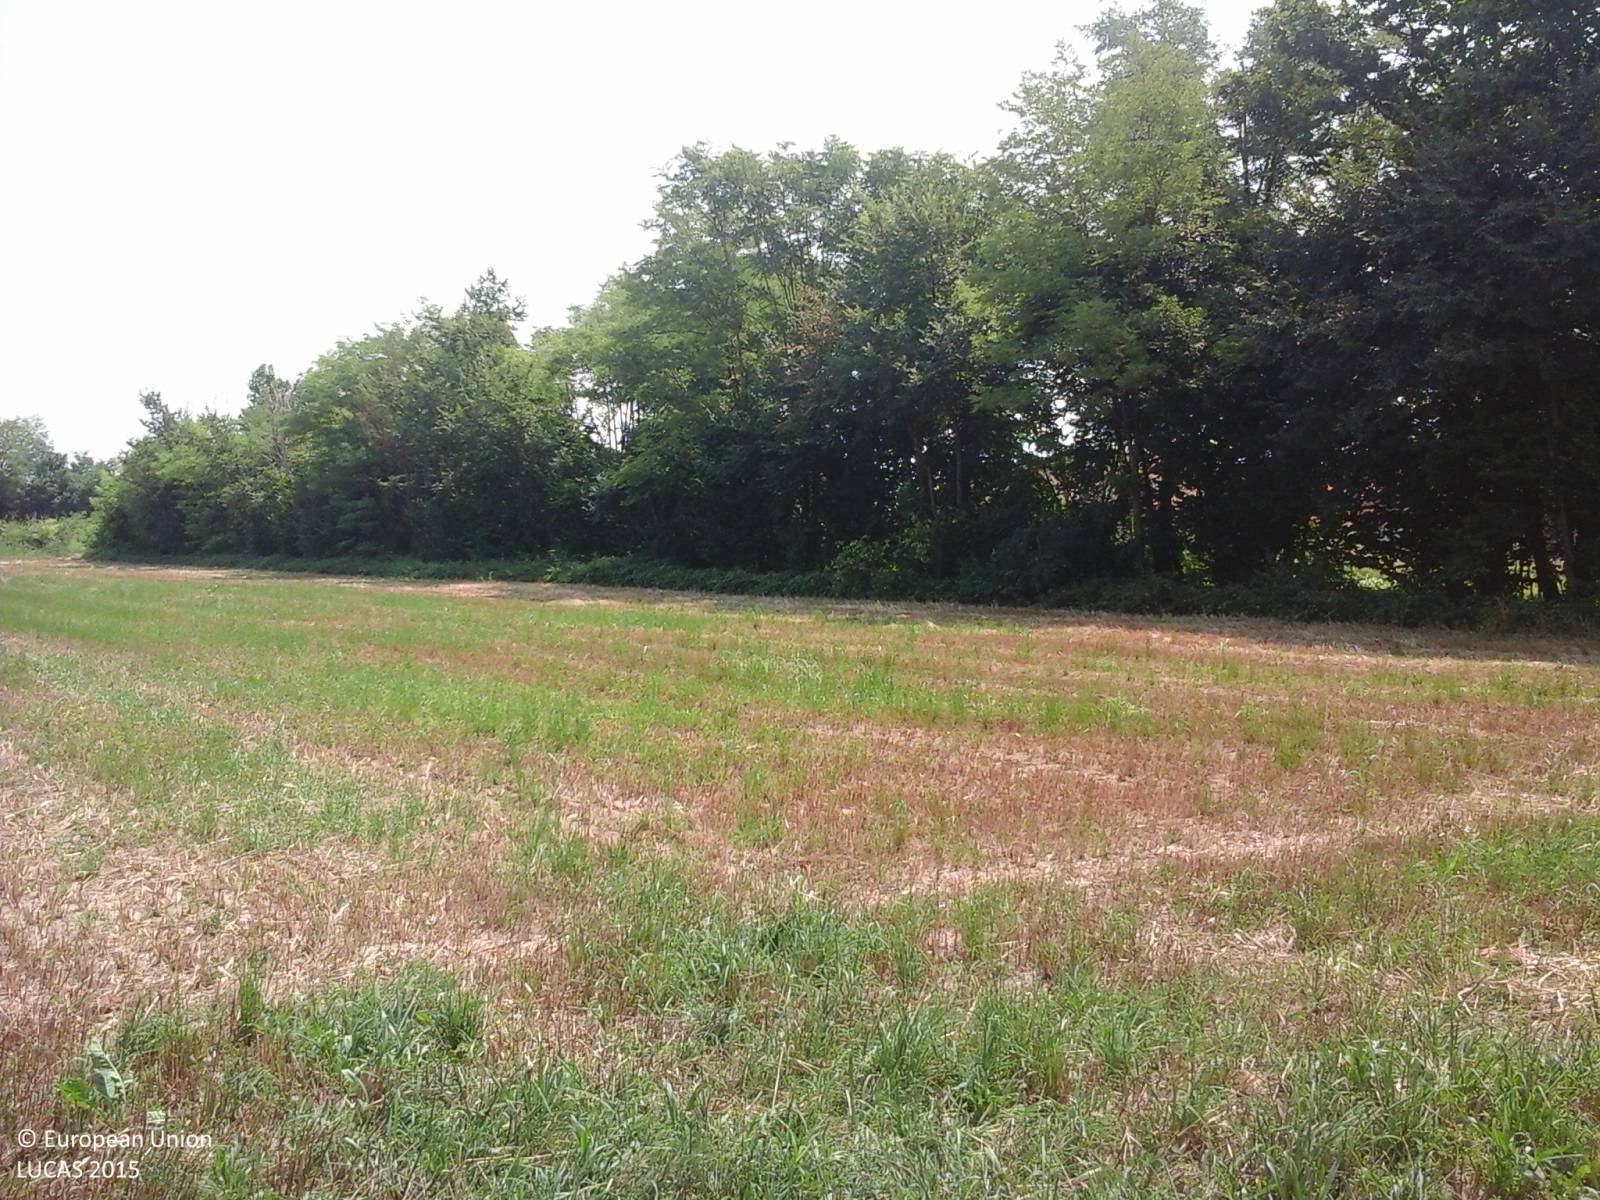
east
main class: Grassland
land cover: Spontaneously vegetated surfaces
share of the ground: > 75 %
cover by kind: herbaceous plants 100 %
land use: Agriculture (excluding fallow land and kitchen gardens)
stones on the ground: 10 - 25 %
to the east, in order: Spontaneously vegetated surfaces; Broadleaved woodland; Tracks; Broadleaved woodland; Spontaneously vegetated surfaces; Abandoned hedges; Grass margins; Paved roads, cycling and walking lanes; Grass margins; Managed hedges; Grassland without tree/shrub cover; Vineyards; Grassland with sparse tree/shrub cover; Artificial constructions in urban areas
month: July
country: IT
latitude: 45.9755
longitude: 12.6683
